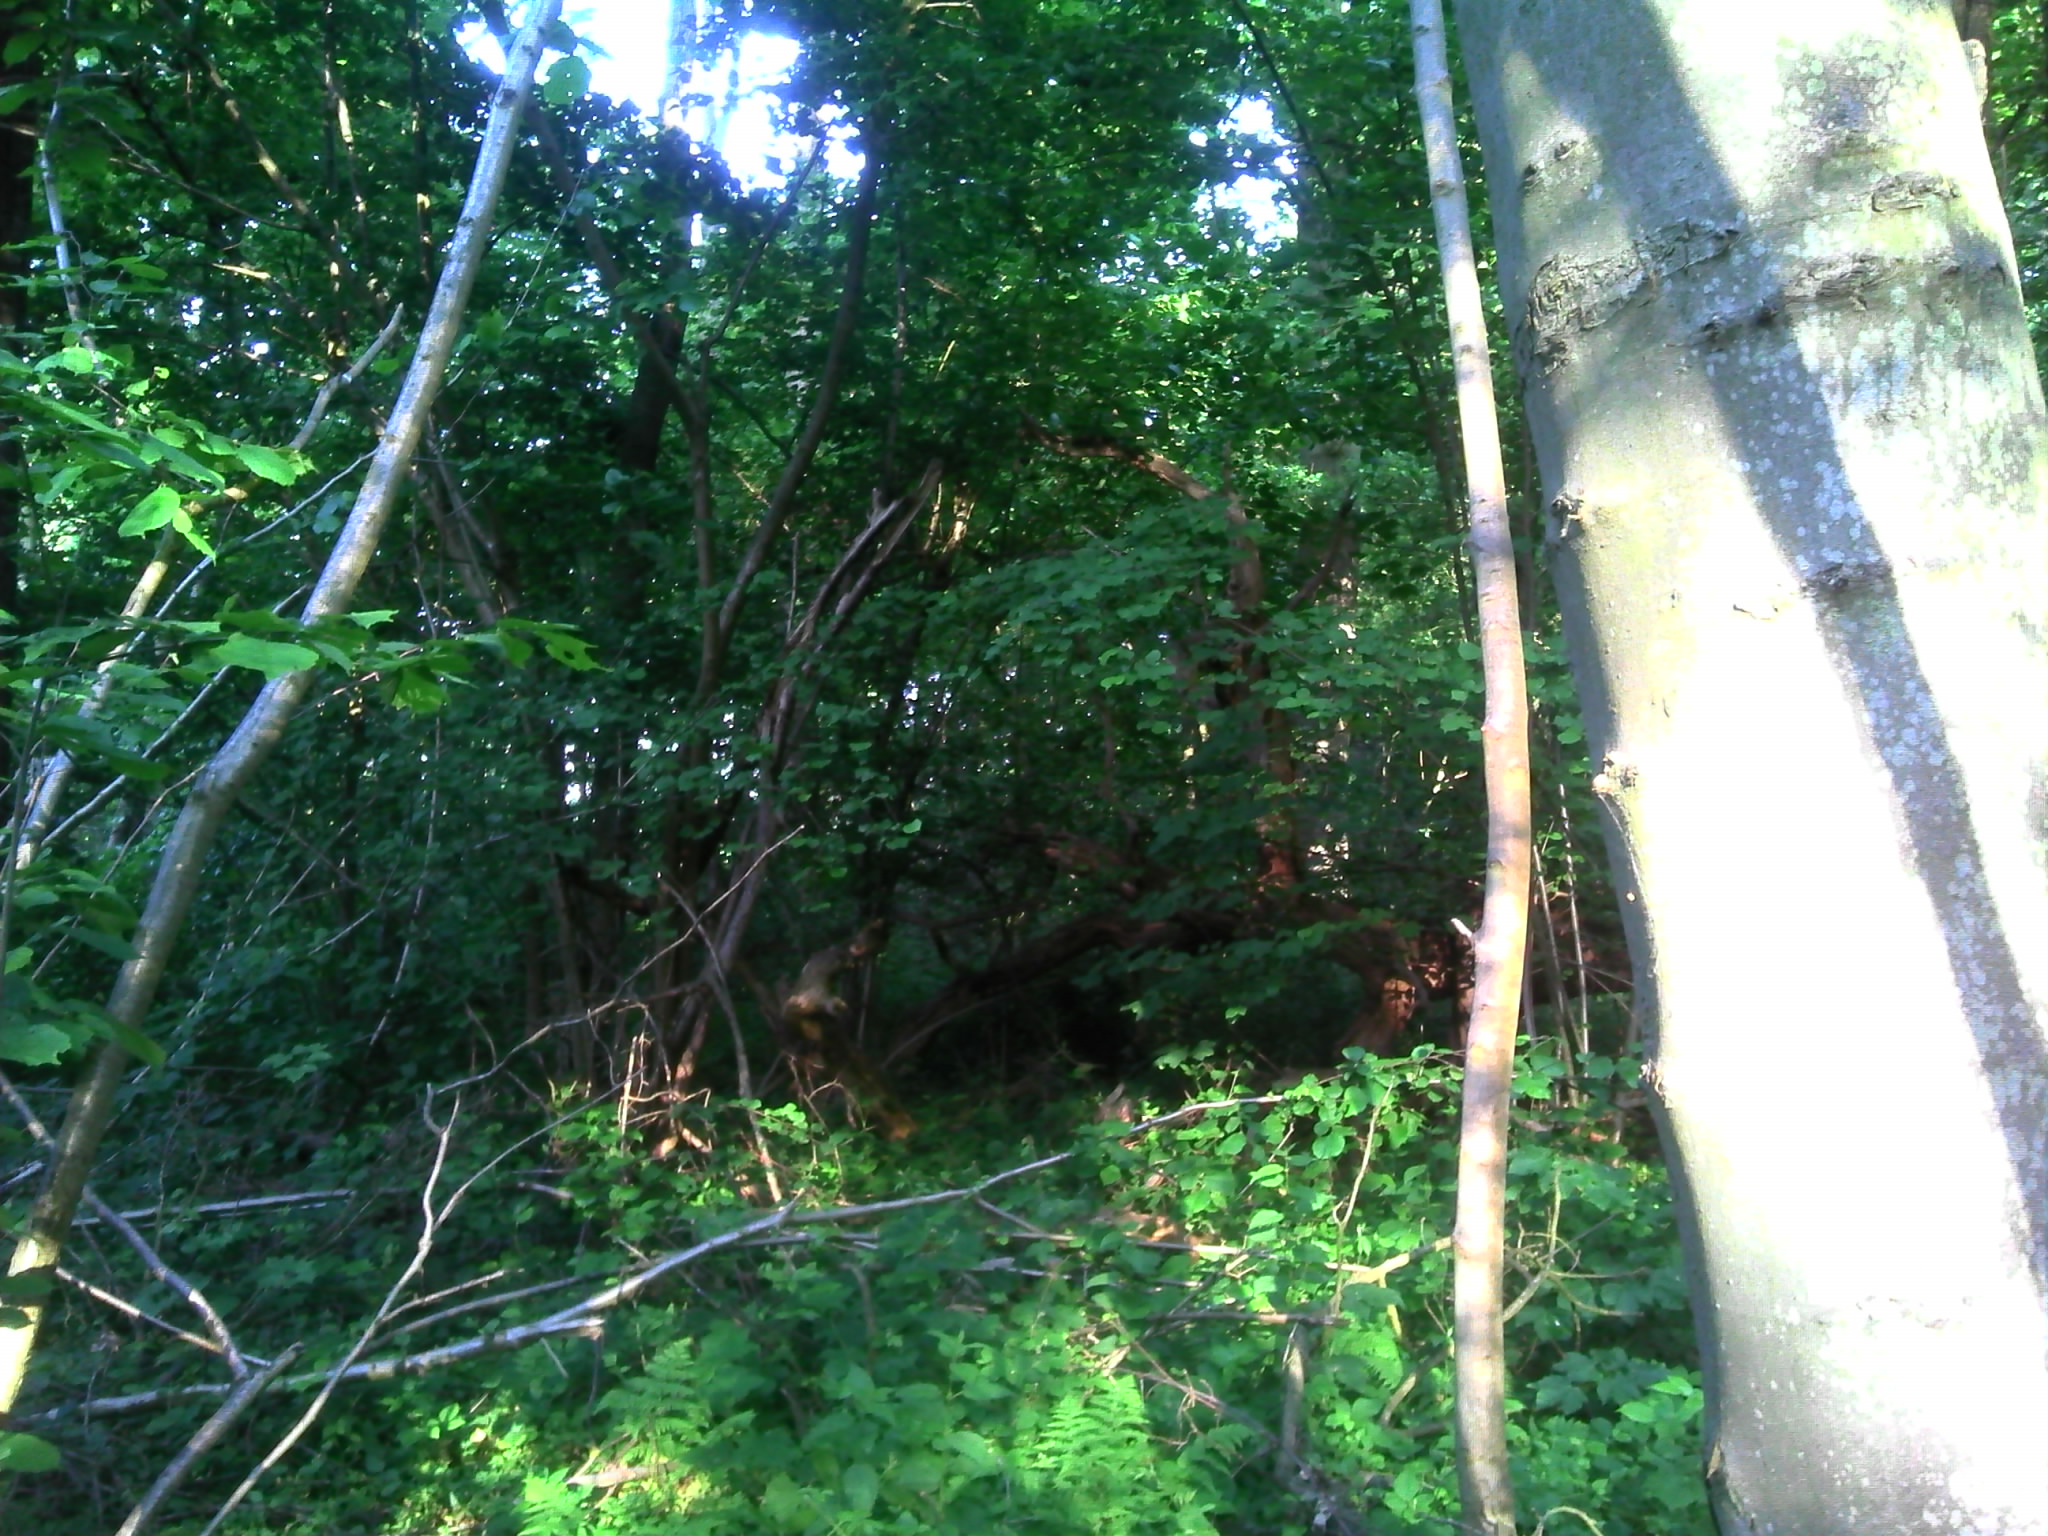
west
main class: Woodland
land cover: Broadleaved woodland
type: mesophytic deciduous forest
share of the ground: > 75 %
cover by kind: broadleaved forest trees 85 %, herbaceous plants 15 %
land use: Forestry
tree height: > 5 m
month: June
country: BE
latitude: 50.5875
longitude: 4.7847
